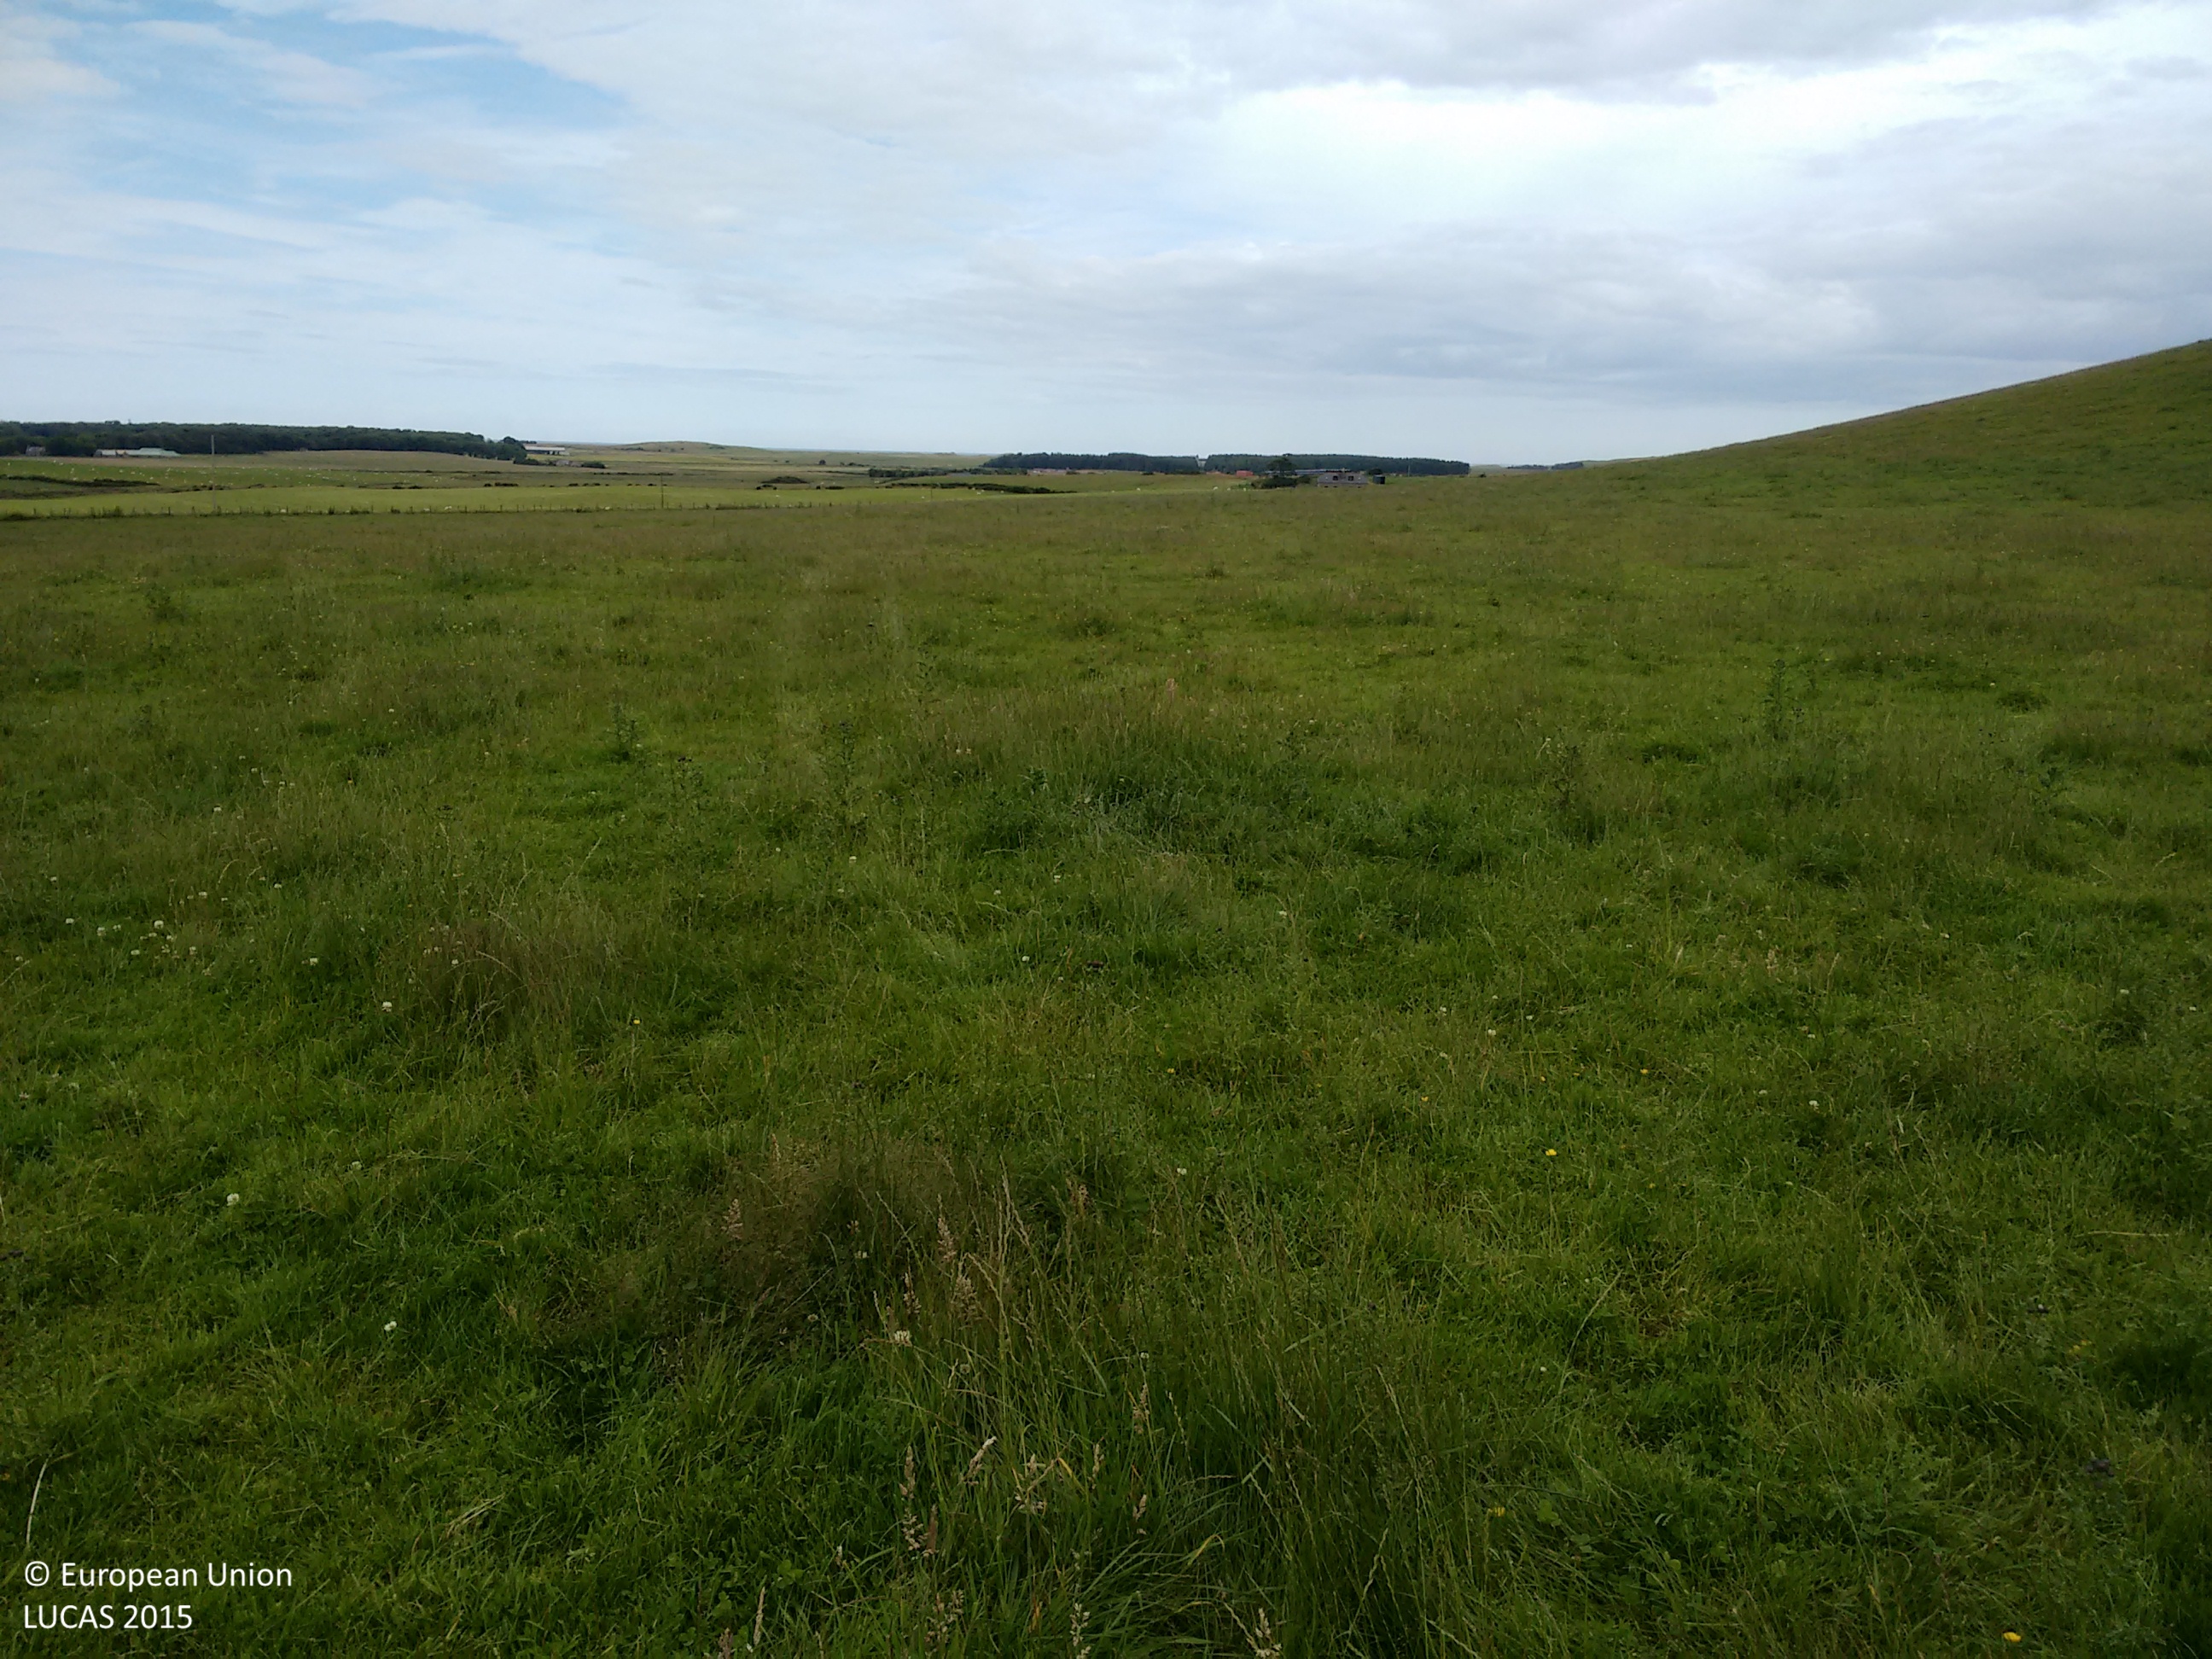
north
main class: Grassland
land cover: Grassland without tree/shrub cover
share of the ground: > 75 %
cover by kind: herbaceous plants 100 %
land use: Agriculture (excluding fallow land and kitchen gardens)
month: July
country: GB
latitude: 57.6441
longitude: -1.9893
